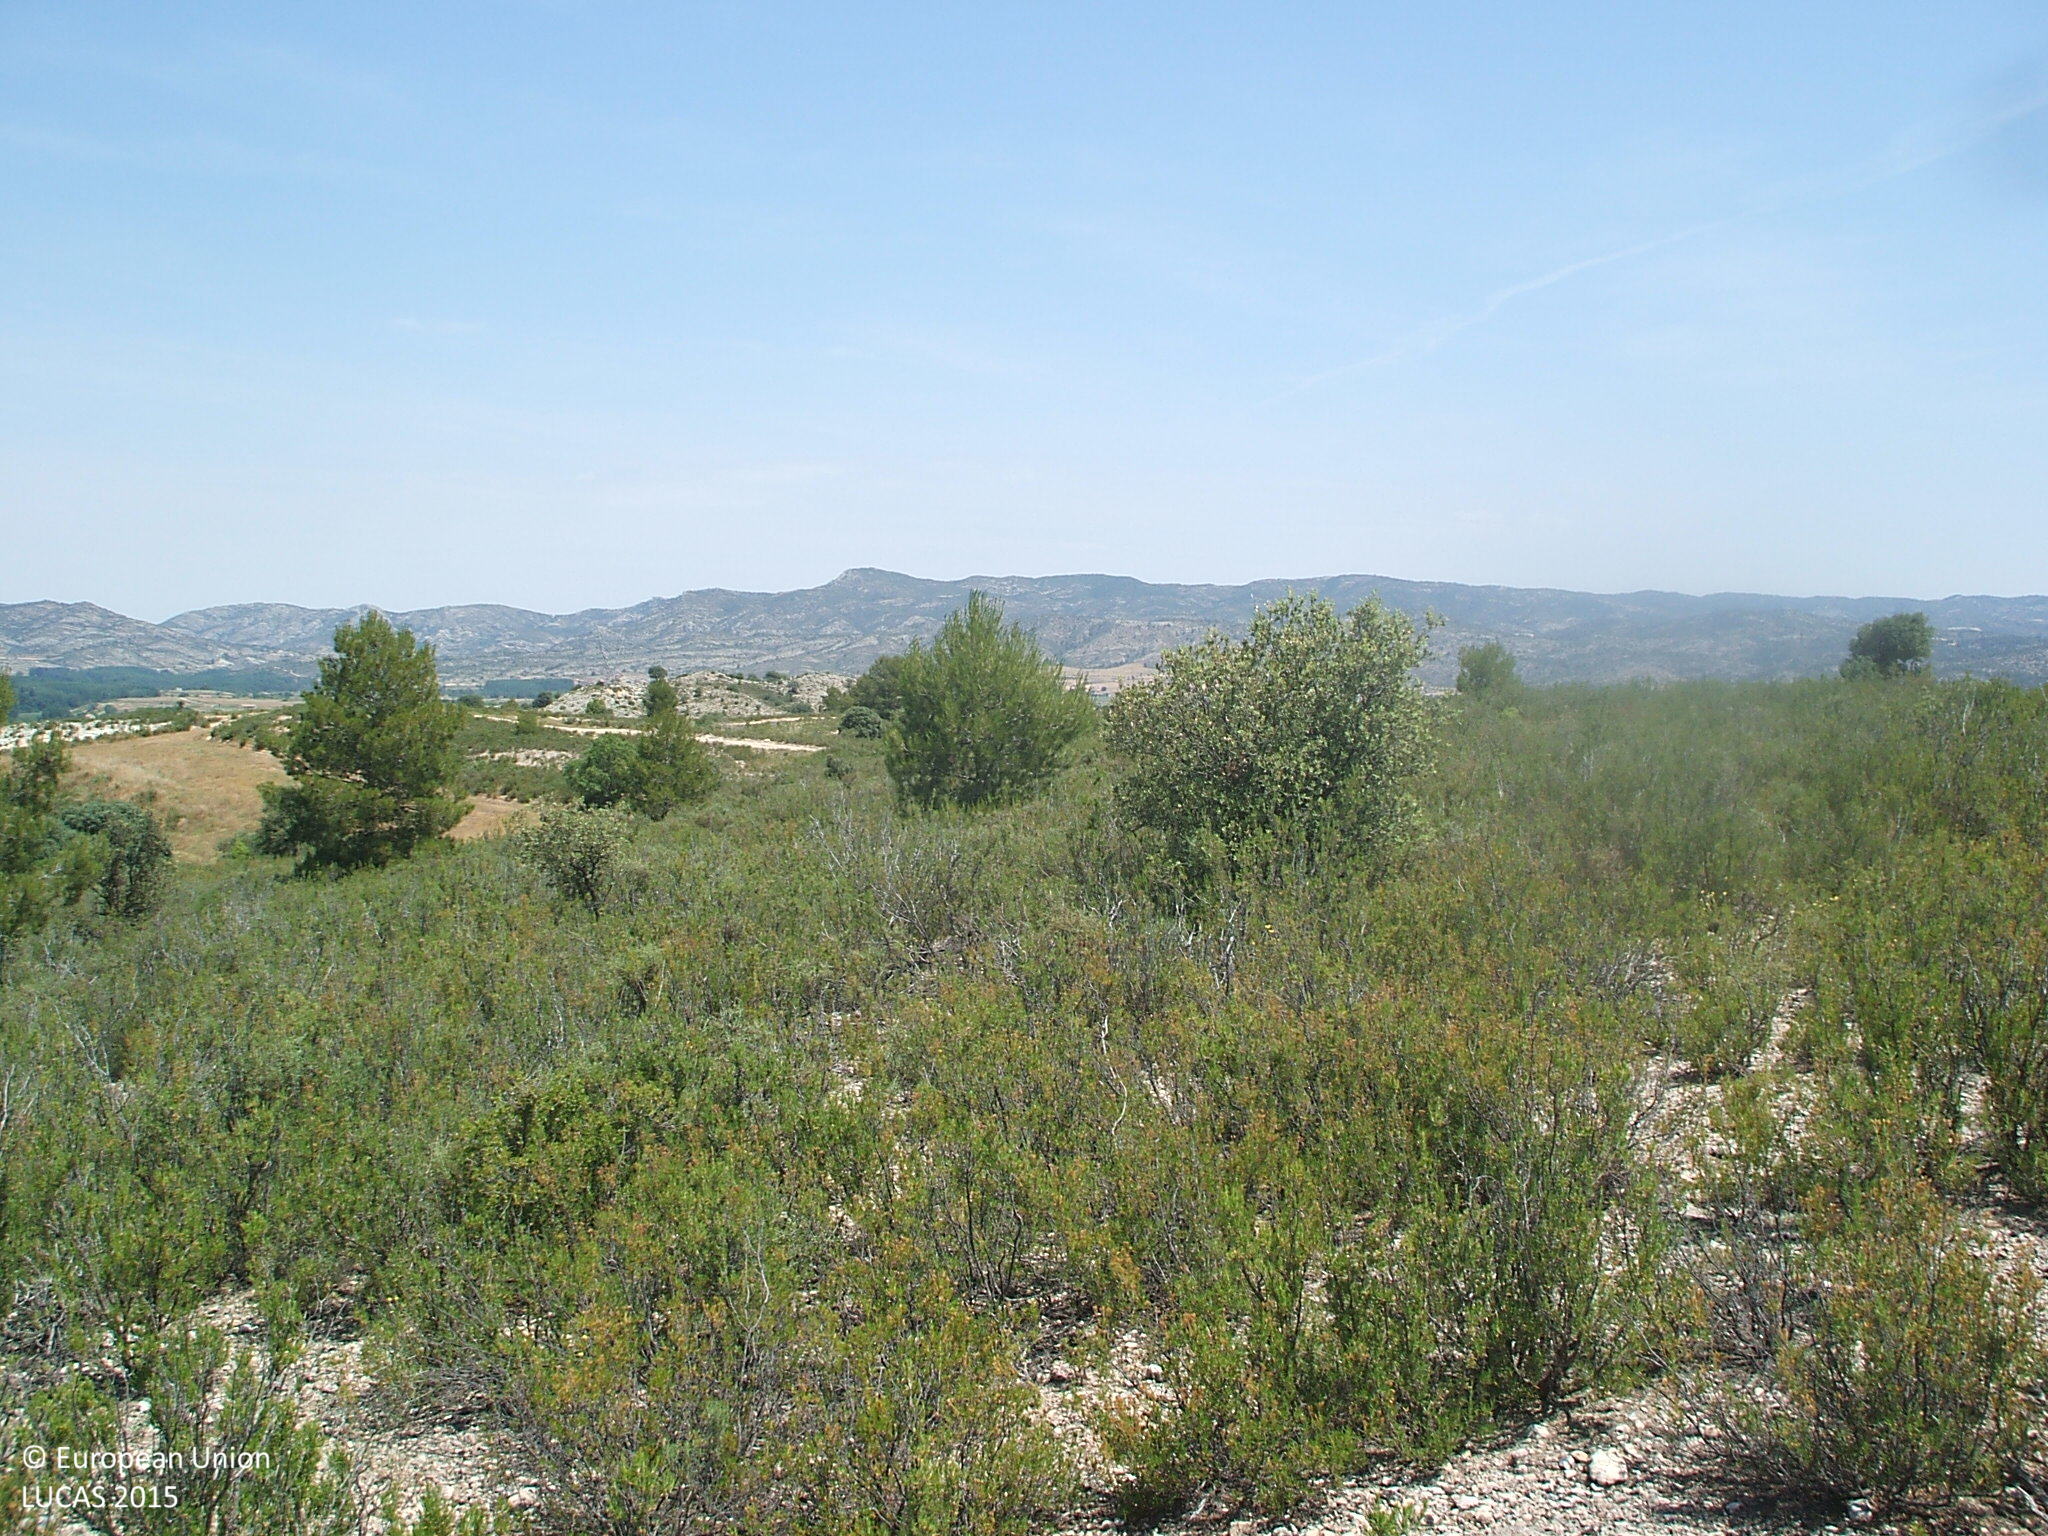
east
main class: Shrubland
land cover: Shrubland with sparse tree cover
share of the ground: > 75 %
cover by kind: shrubs 80 %, consolidated bare surface 15 %, coniferous forest trees 5 %
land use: Semi-natural and natural areas not in use
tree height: > 5 m
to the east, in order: Shrubland with sparse tree cover; Tracks; Grassland without tree/shrub cover; Abandoned hedges; Olive groves; Dry stone walls; Grass margins; Olive groves; Shrubland with sparse tree cover
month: June
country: ES
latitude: 40.8254
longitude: -0.2189
